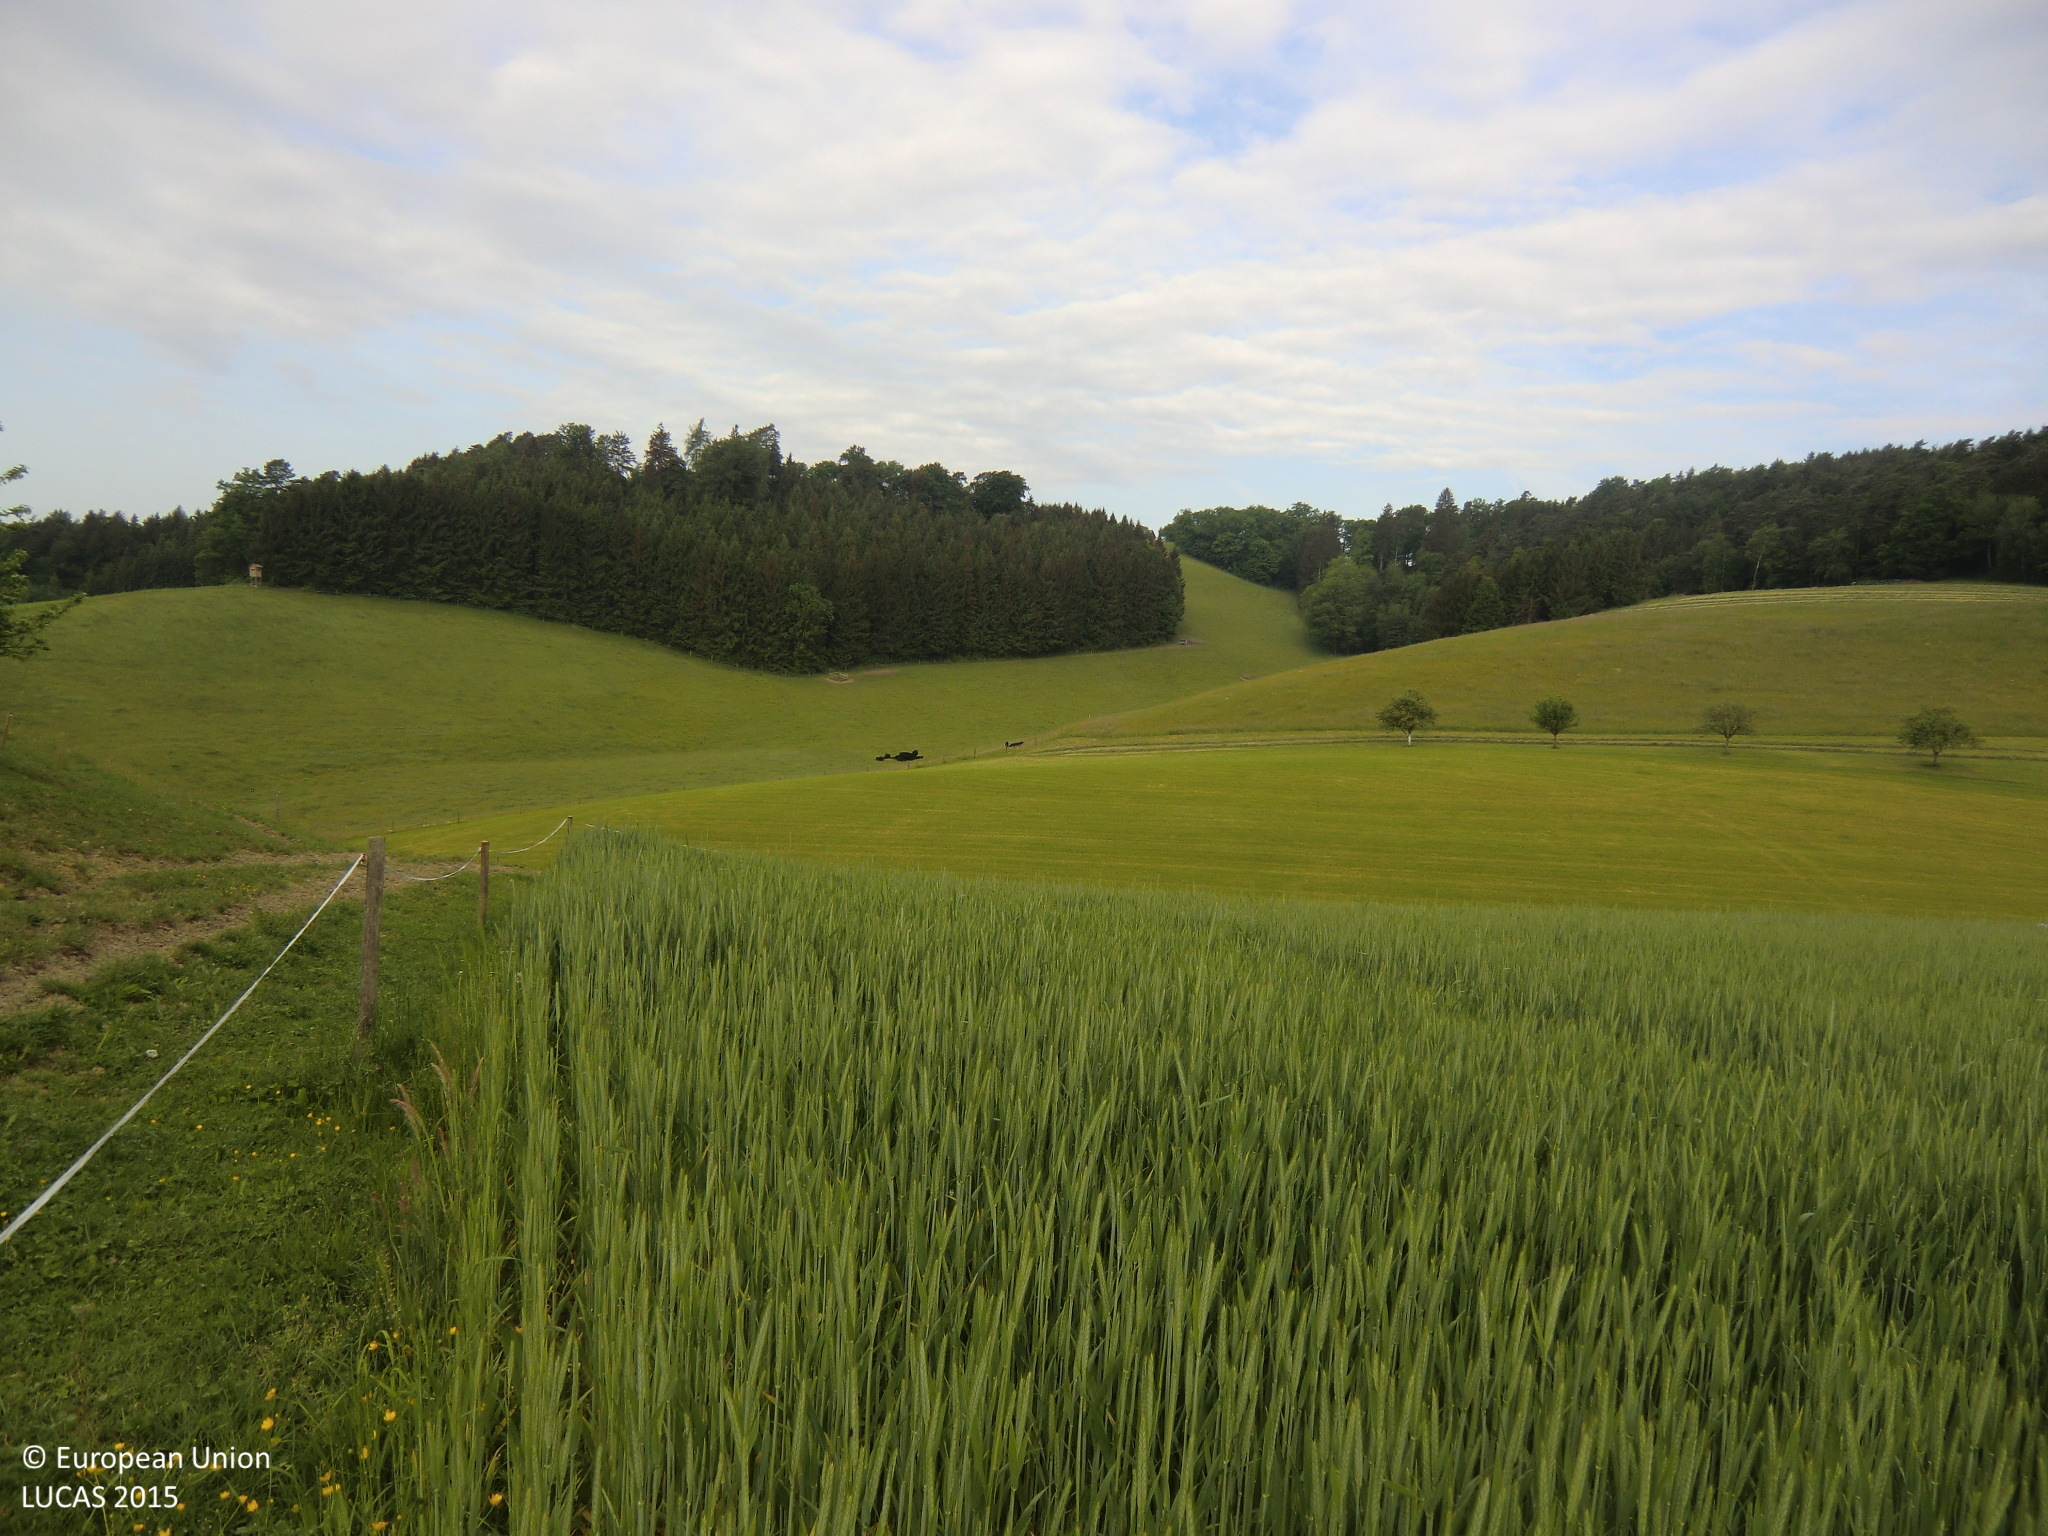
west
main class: Grassland
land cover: Grassland without tree/shrub cover
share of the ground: > 75 %
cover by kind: herbaceous plants 80 %, unconsolidated bare surface 20 %
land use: Agriculture (excluding fallow land and kitchen gardens)
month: May
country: AT
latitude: 48.3079
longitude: 14.5983
